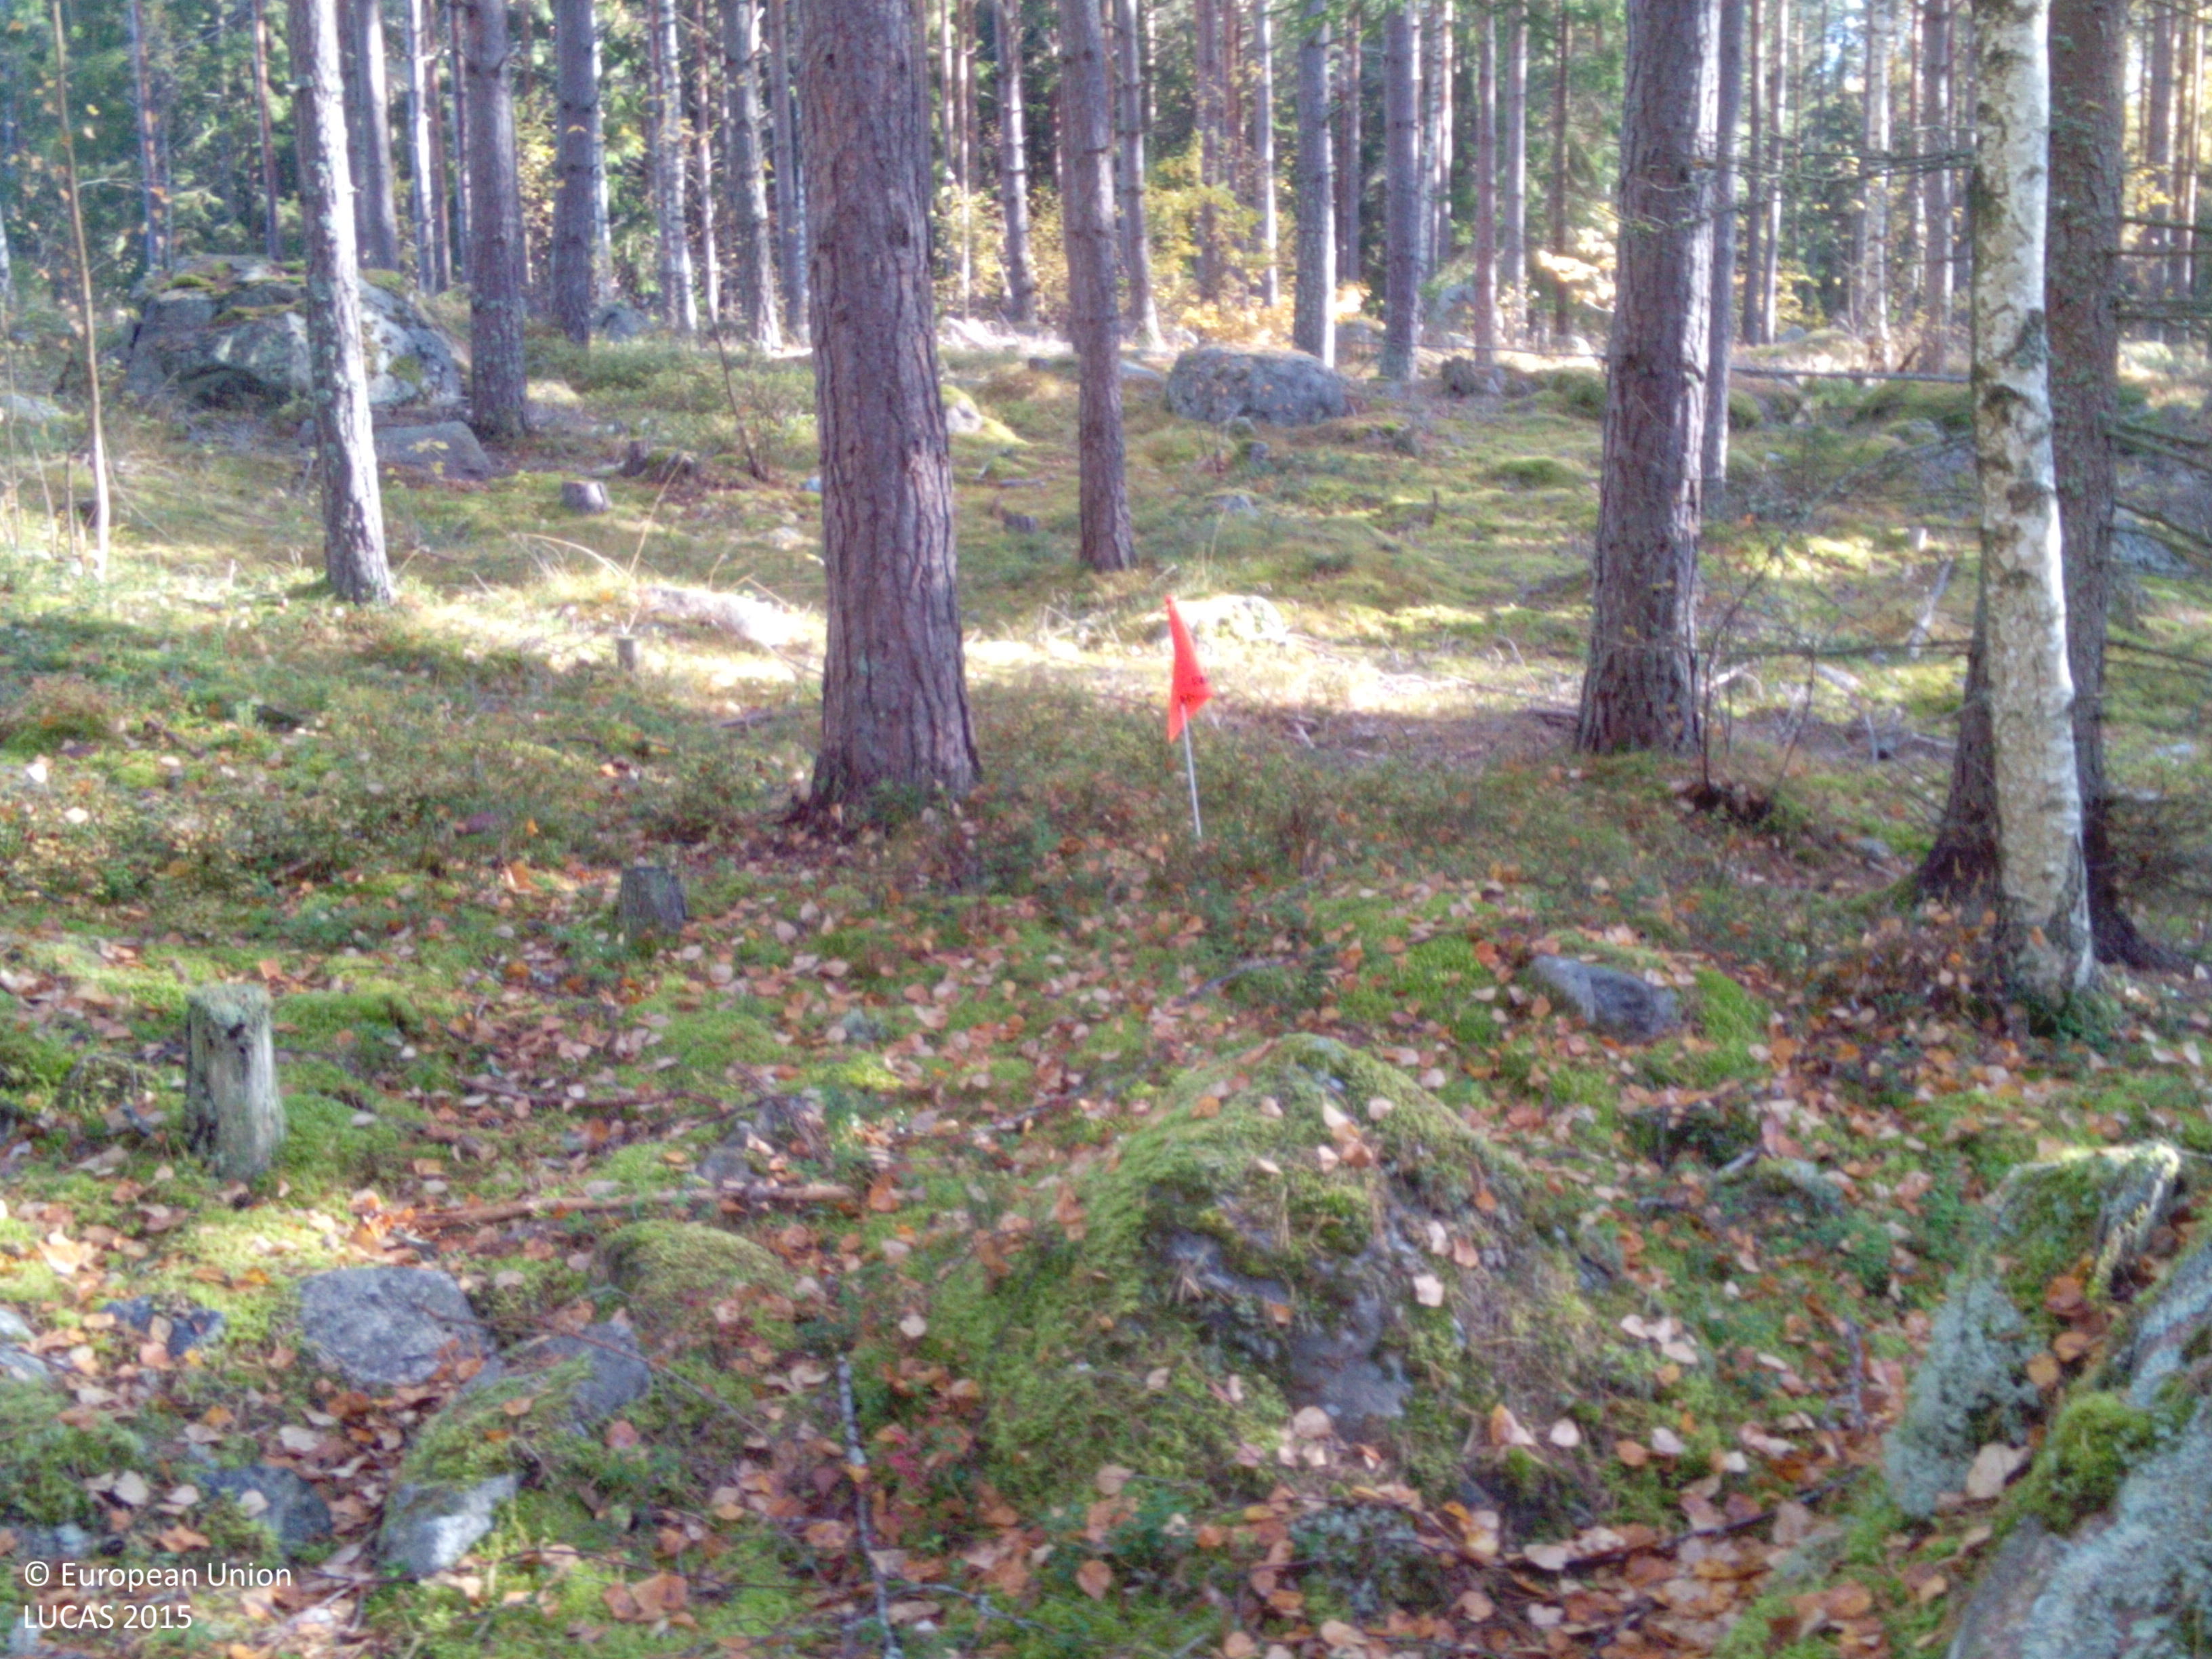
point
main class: Woodland
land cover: Pine dominated coniferous woodland
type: boreal forest
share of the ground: > 75 %
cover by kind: coniferous forest trees 75 %, broadleaved forest trees 10 %, lichens and mosses 10 %, herbaceous plants 5 %
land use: Forestry
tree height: > 5 m
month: October
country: SE
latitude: 59.0261
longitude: 16.3525
